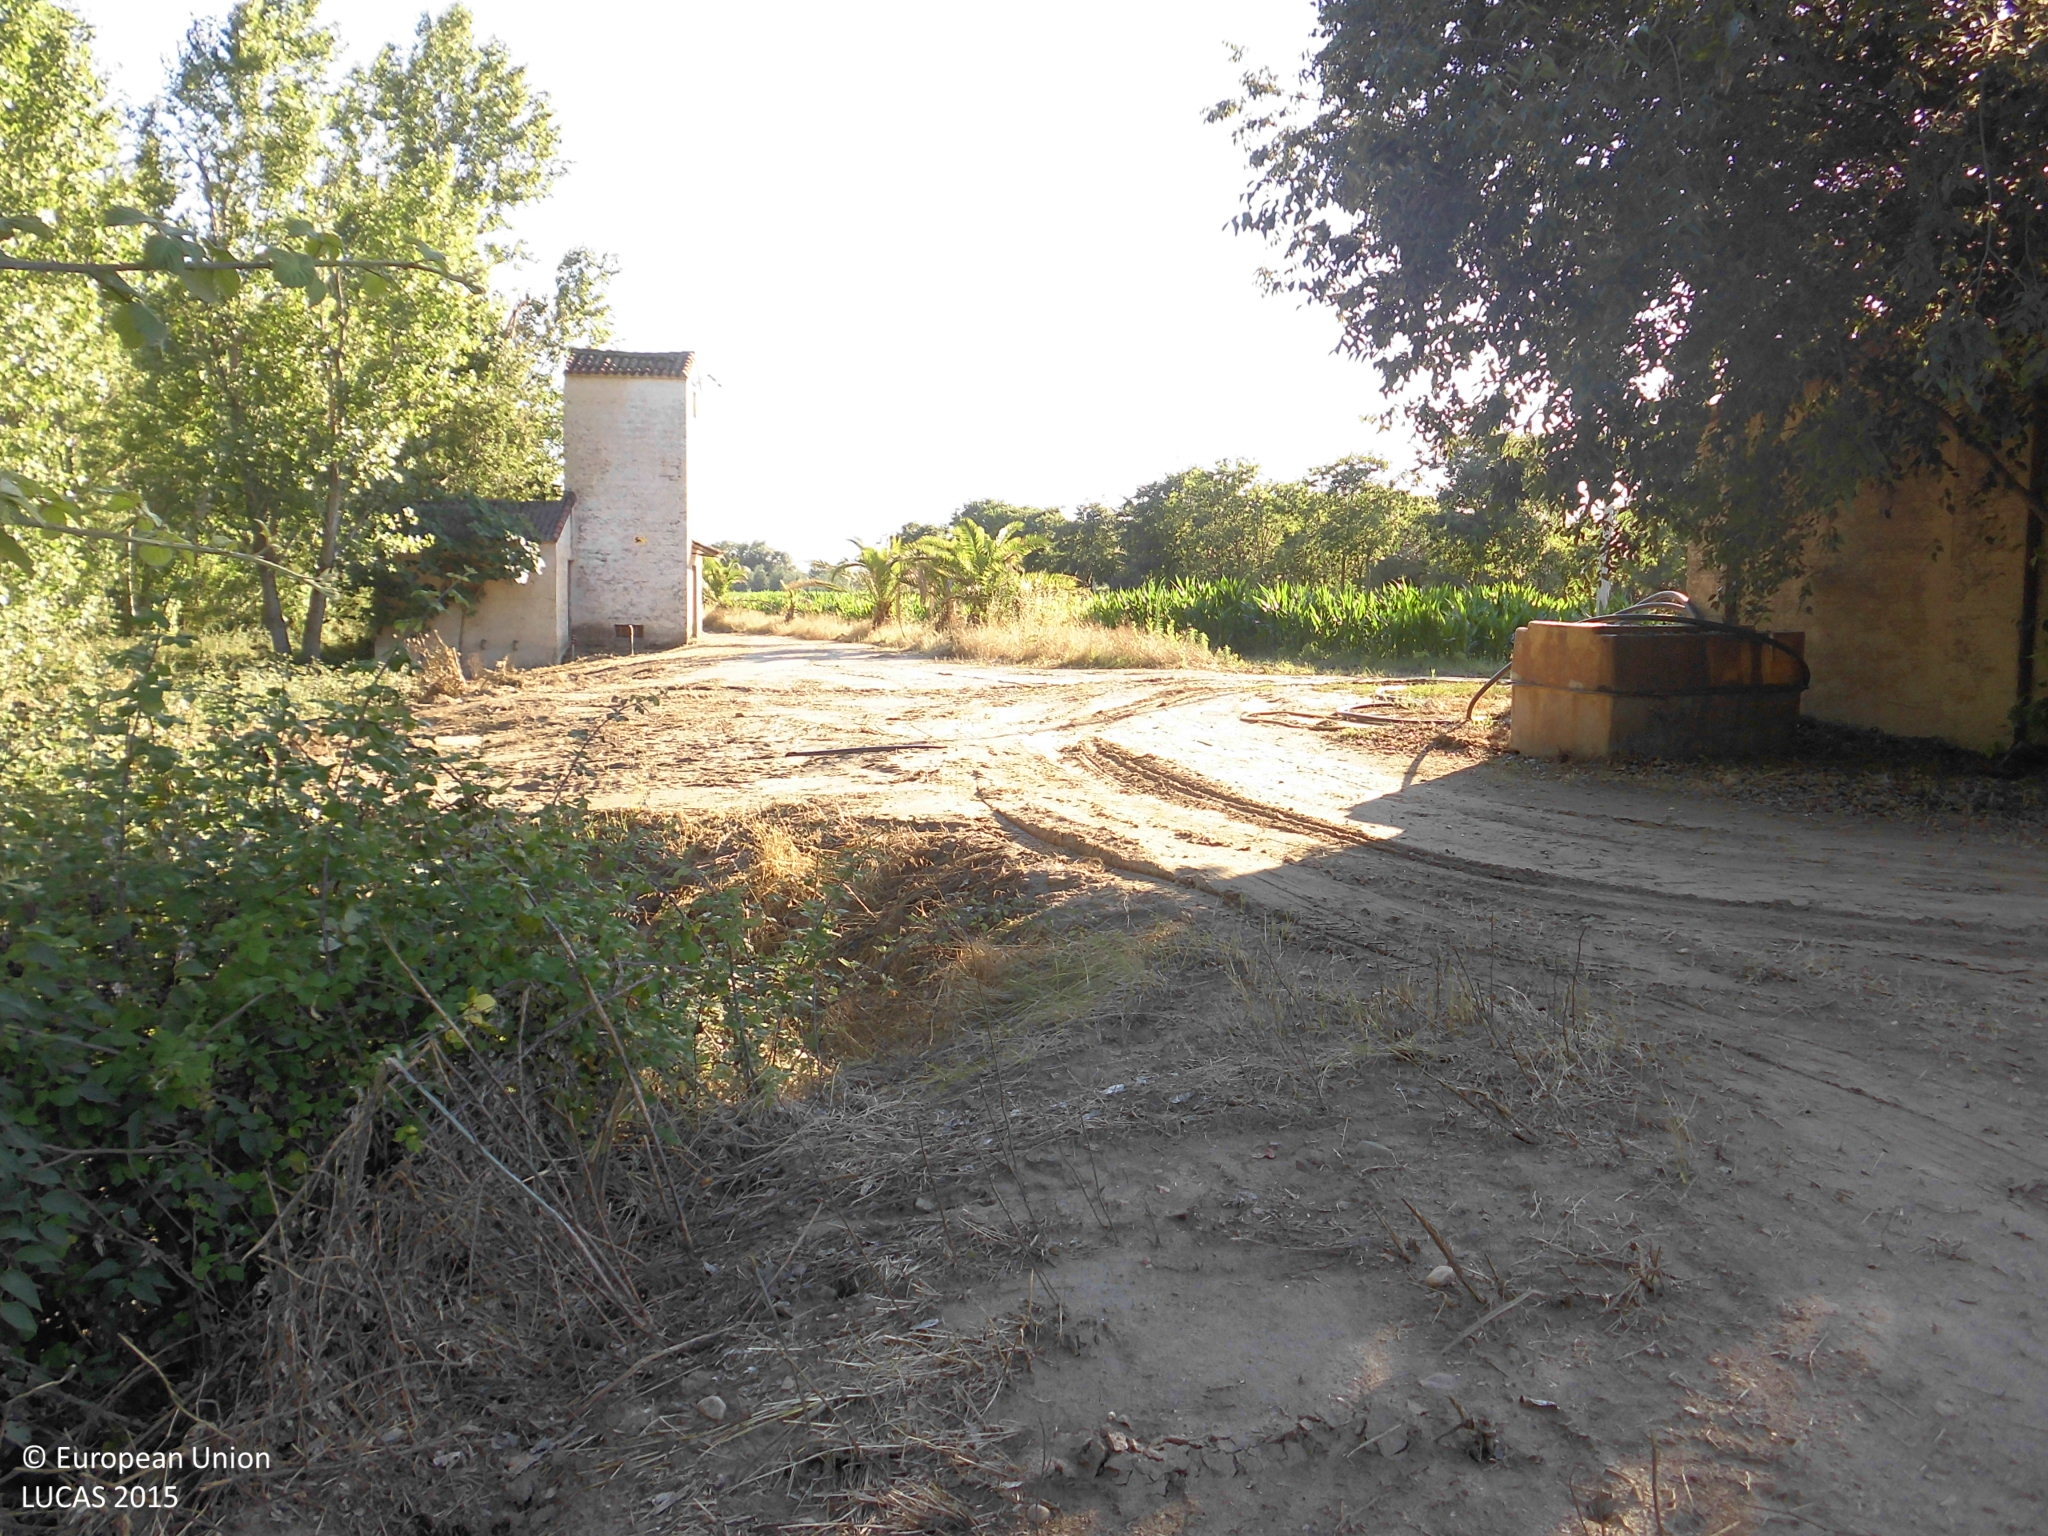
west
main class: Woodland
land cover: Broadleaved woodland
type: floodplain forest
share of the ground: > 75 %
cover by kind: broadleaved forest trees 100 %
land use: Semi-natural and natural areas not in use
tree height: > 5 m
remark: Temporary dry
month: June
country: ES
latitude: 39.9365
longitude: -5.8997
